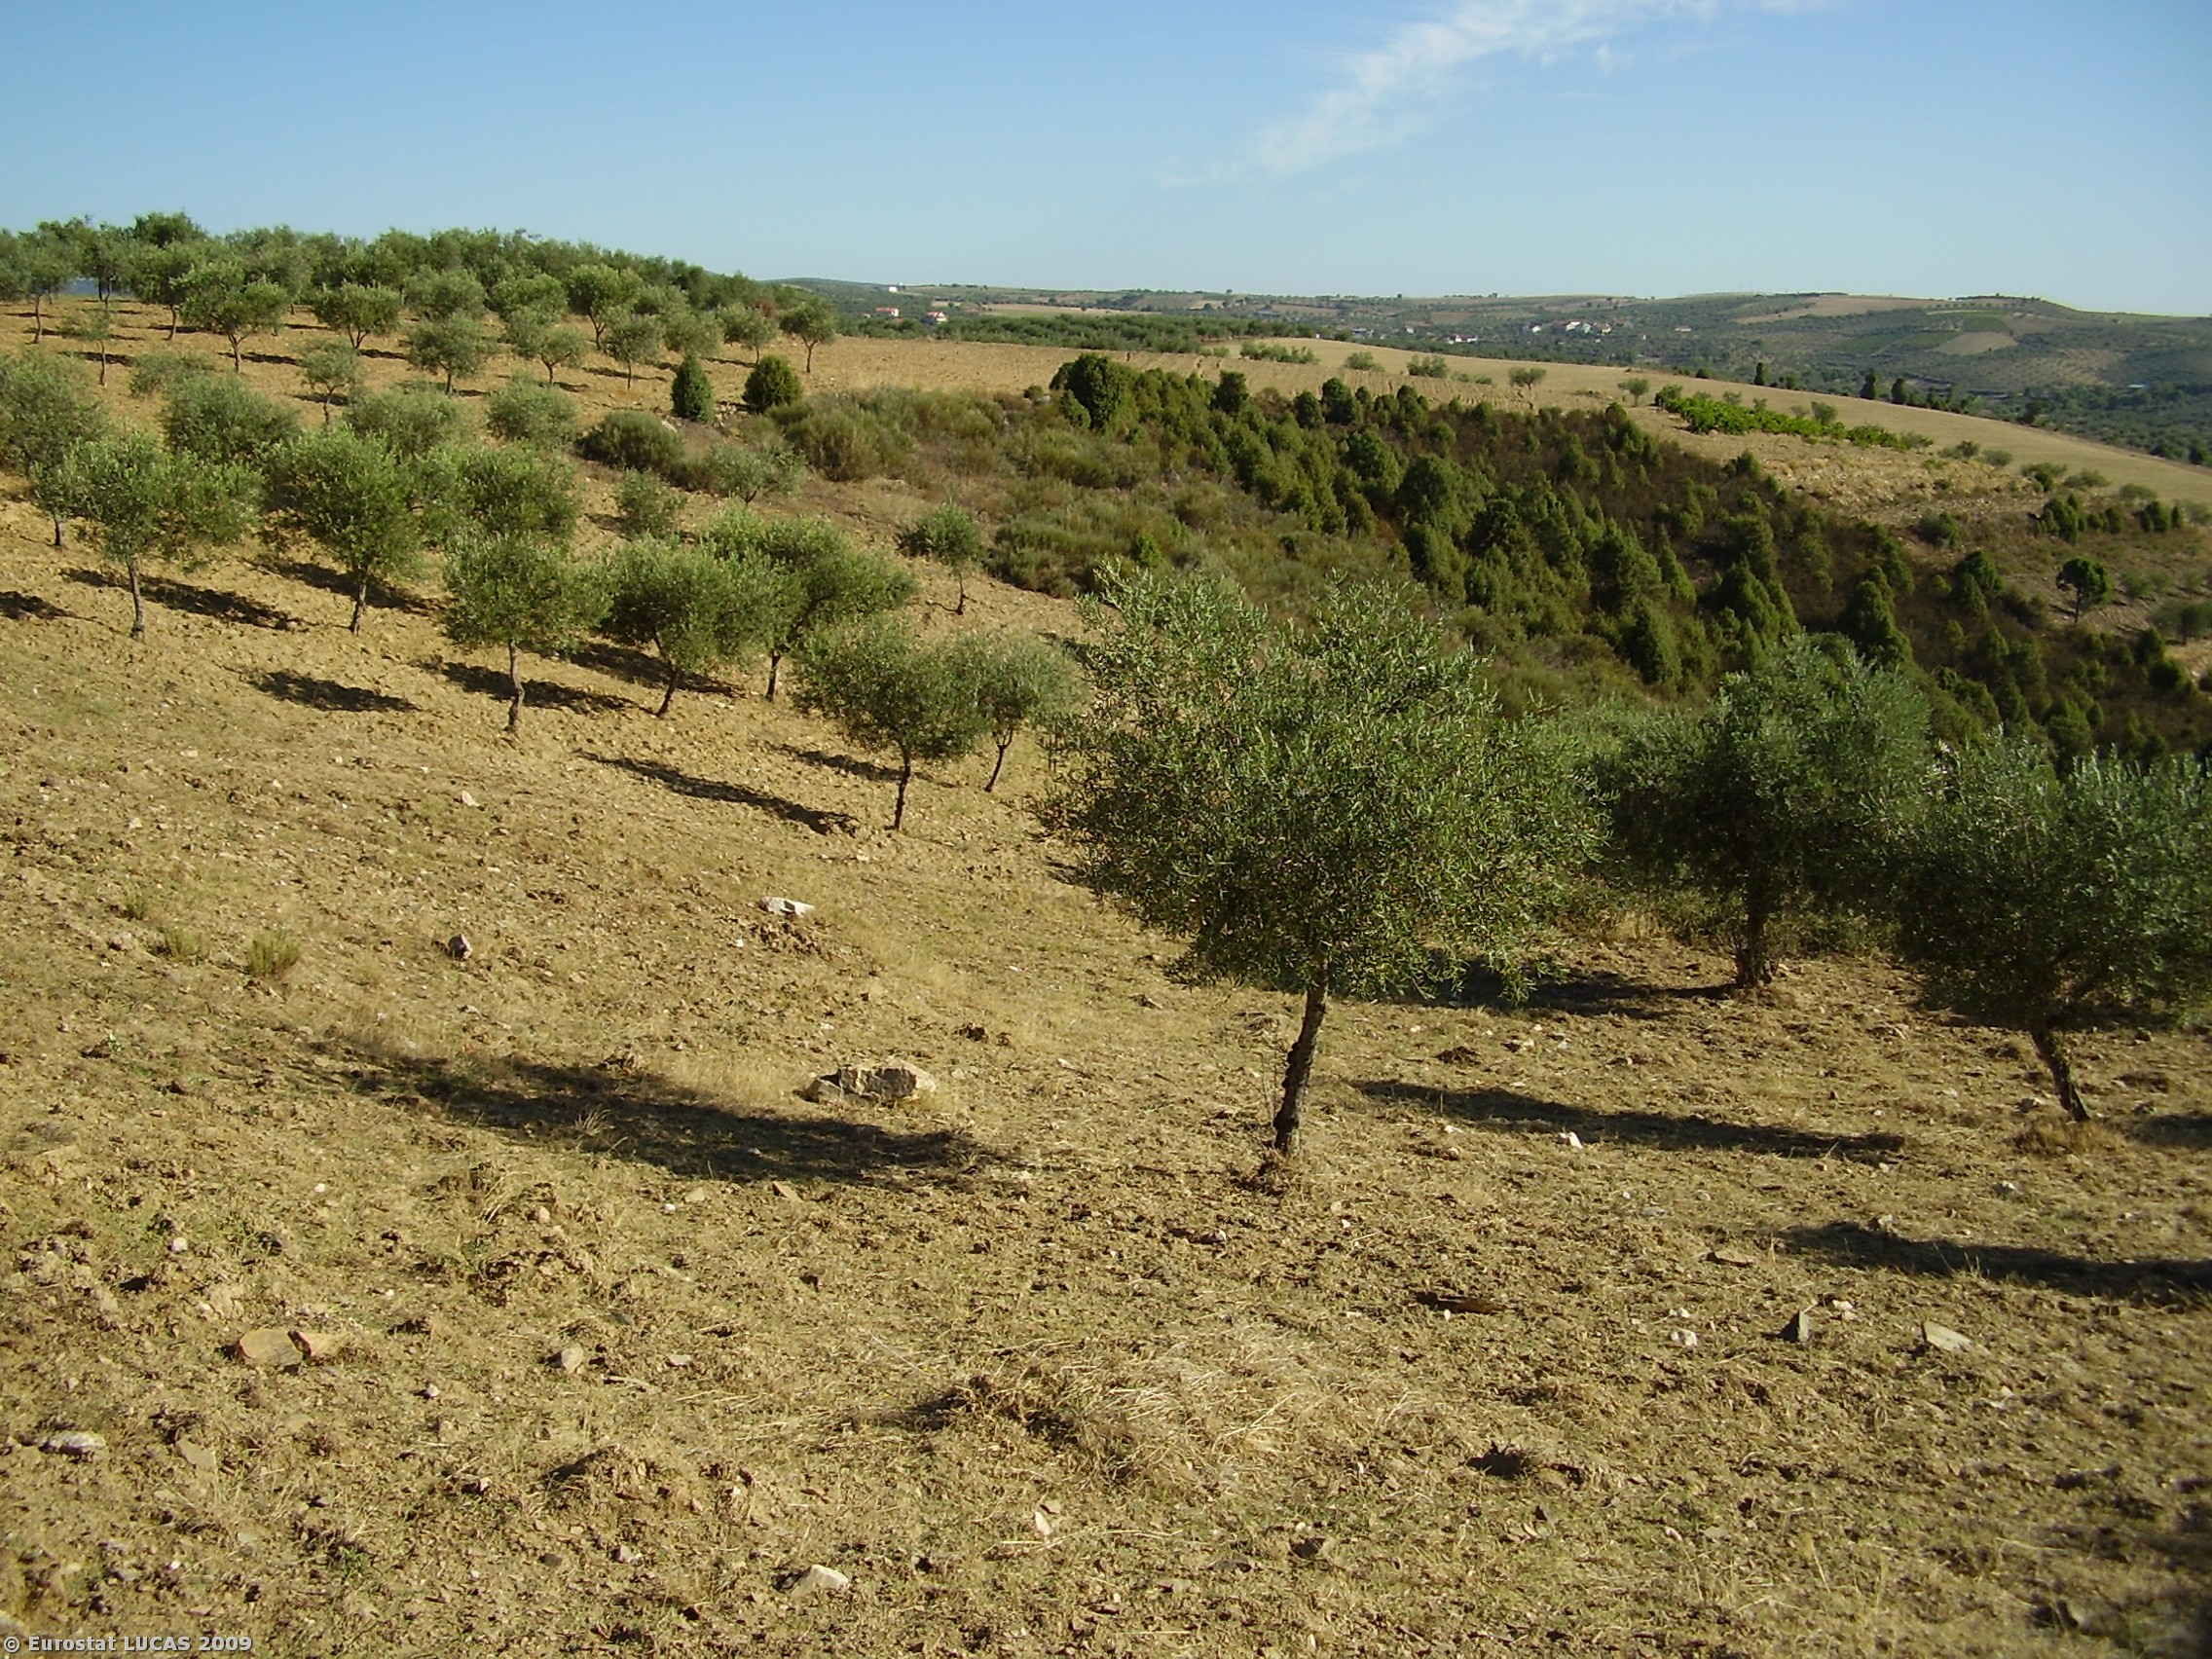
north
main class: Cropland
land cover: Olive groves
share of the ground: 10 - 25 %
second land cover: Spontaneously vegetated surfaces
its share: < 10 %
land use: Agriculture (excluding fallow land and kitchen gardens)
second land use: Fallow land
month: August
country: PT
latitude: 41.4270
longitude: -6.7768
